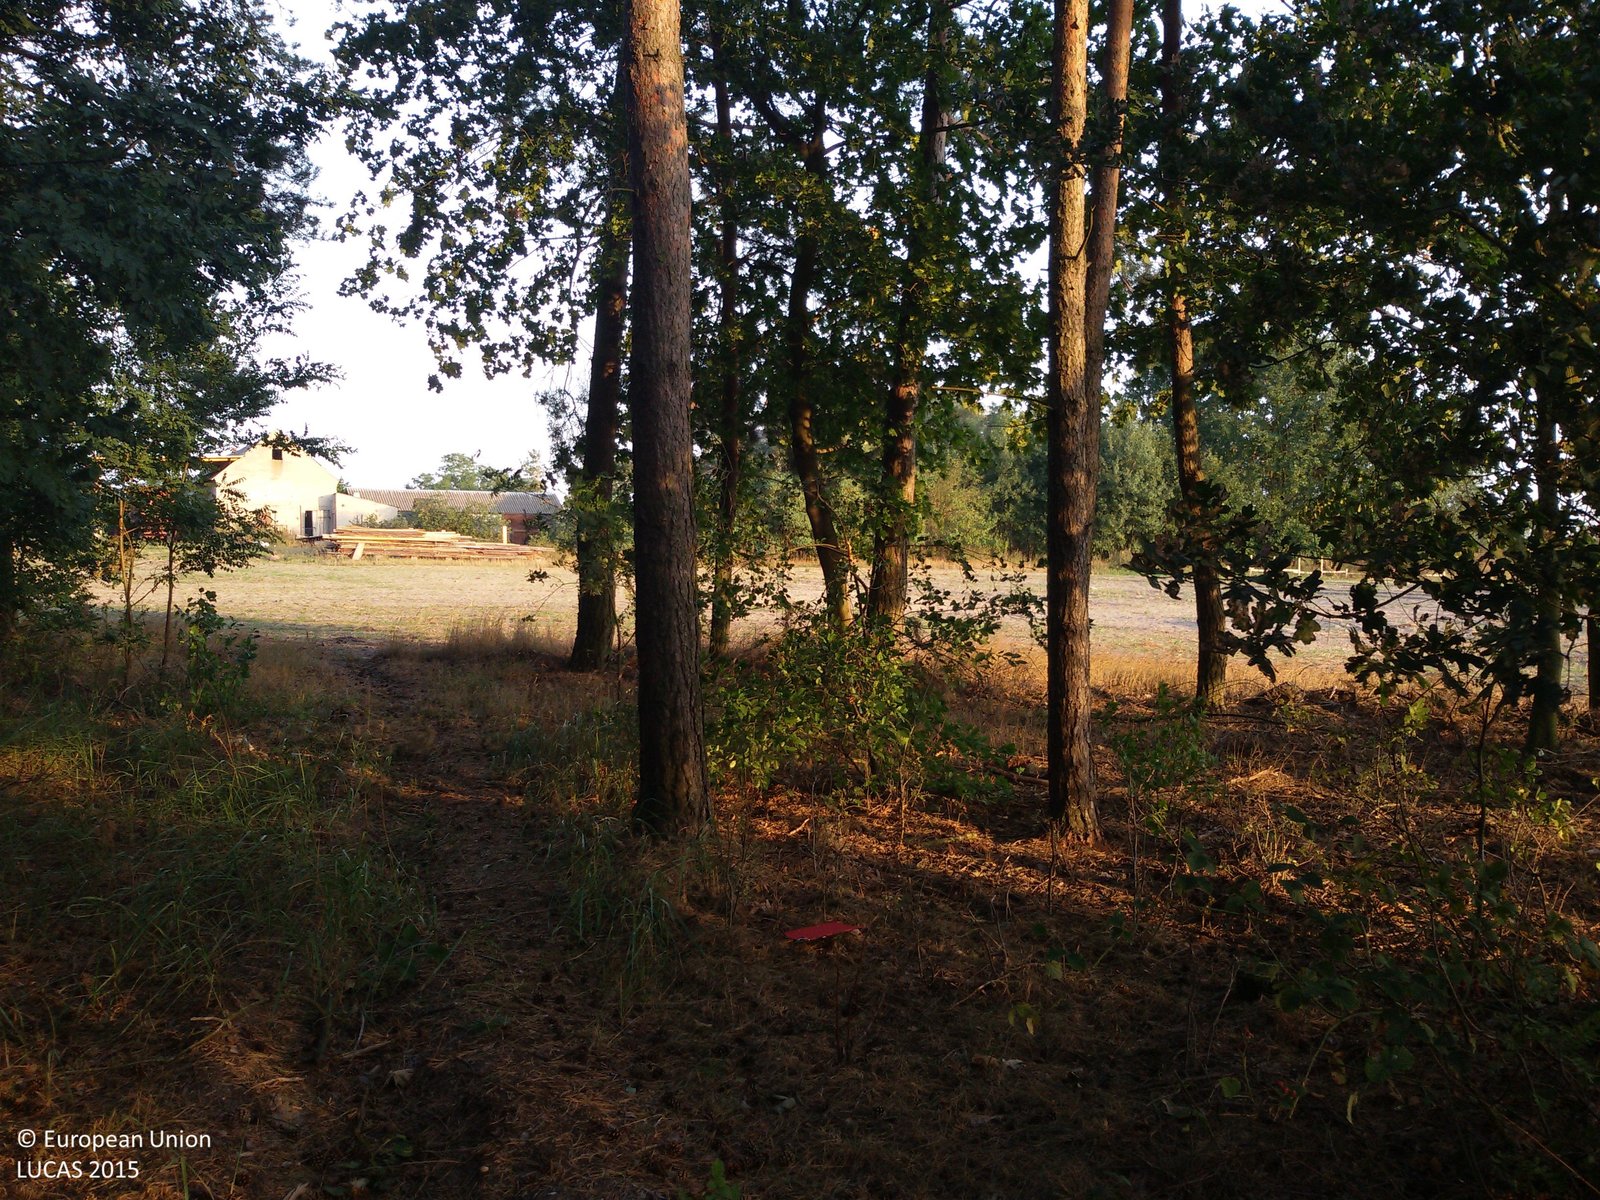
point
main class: Woodland
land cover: Pine dominated coniferous woodland
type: hemiboreal forest and nemoral coniferous forest and mixed broadleaved-coniferous forest
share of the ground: > 75 %
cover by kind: coniferous forest trees 60 %, broadleaved forest trees 20 %, herbaceous plants 10 %, unconsolidated bare surface 10 %
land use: Forestry
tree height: > 5 m
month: September
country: PL
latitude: 52.4145
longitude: 17.9989
